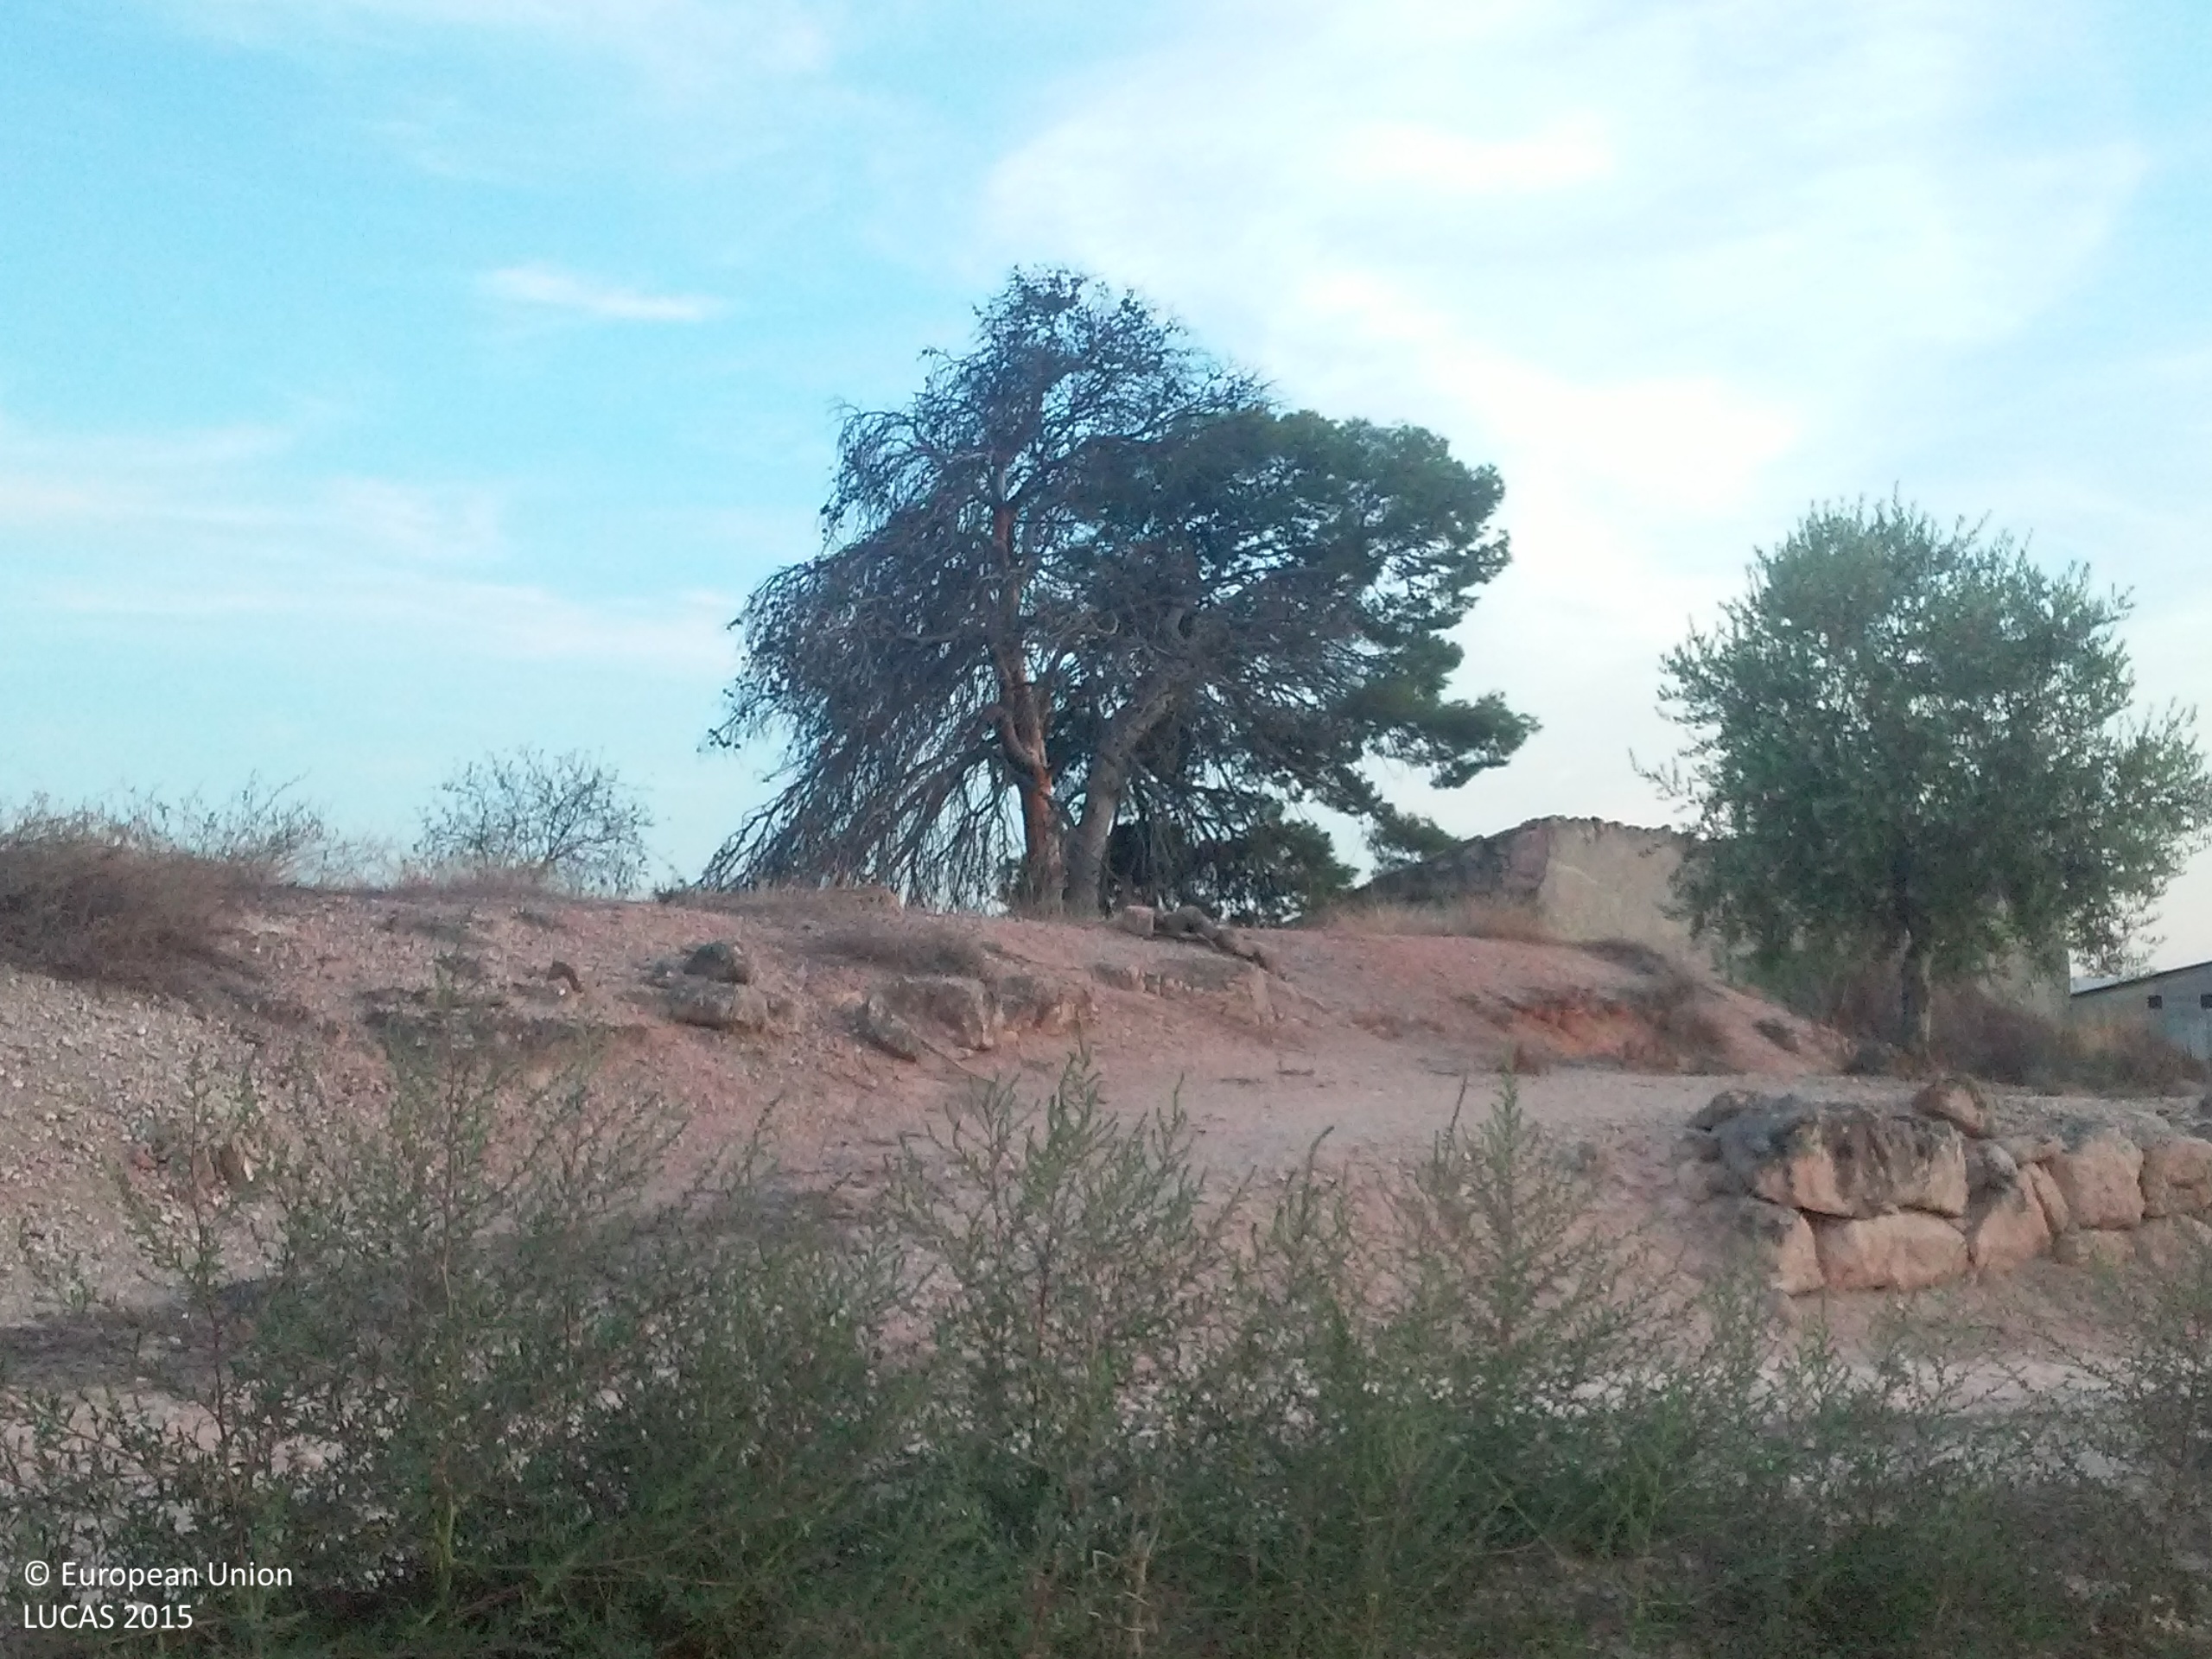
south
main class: Cropland
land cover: Olive groves
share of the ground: 10 - 25 %
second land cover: Spontaneously vegetated surfaces
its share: > 75 %
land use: Agriculture (excluding fallow land and kitchen gardens)
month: August
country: ES
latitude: 41.3286
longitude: 0.6347
